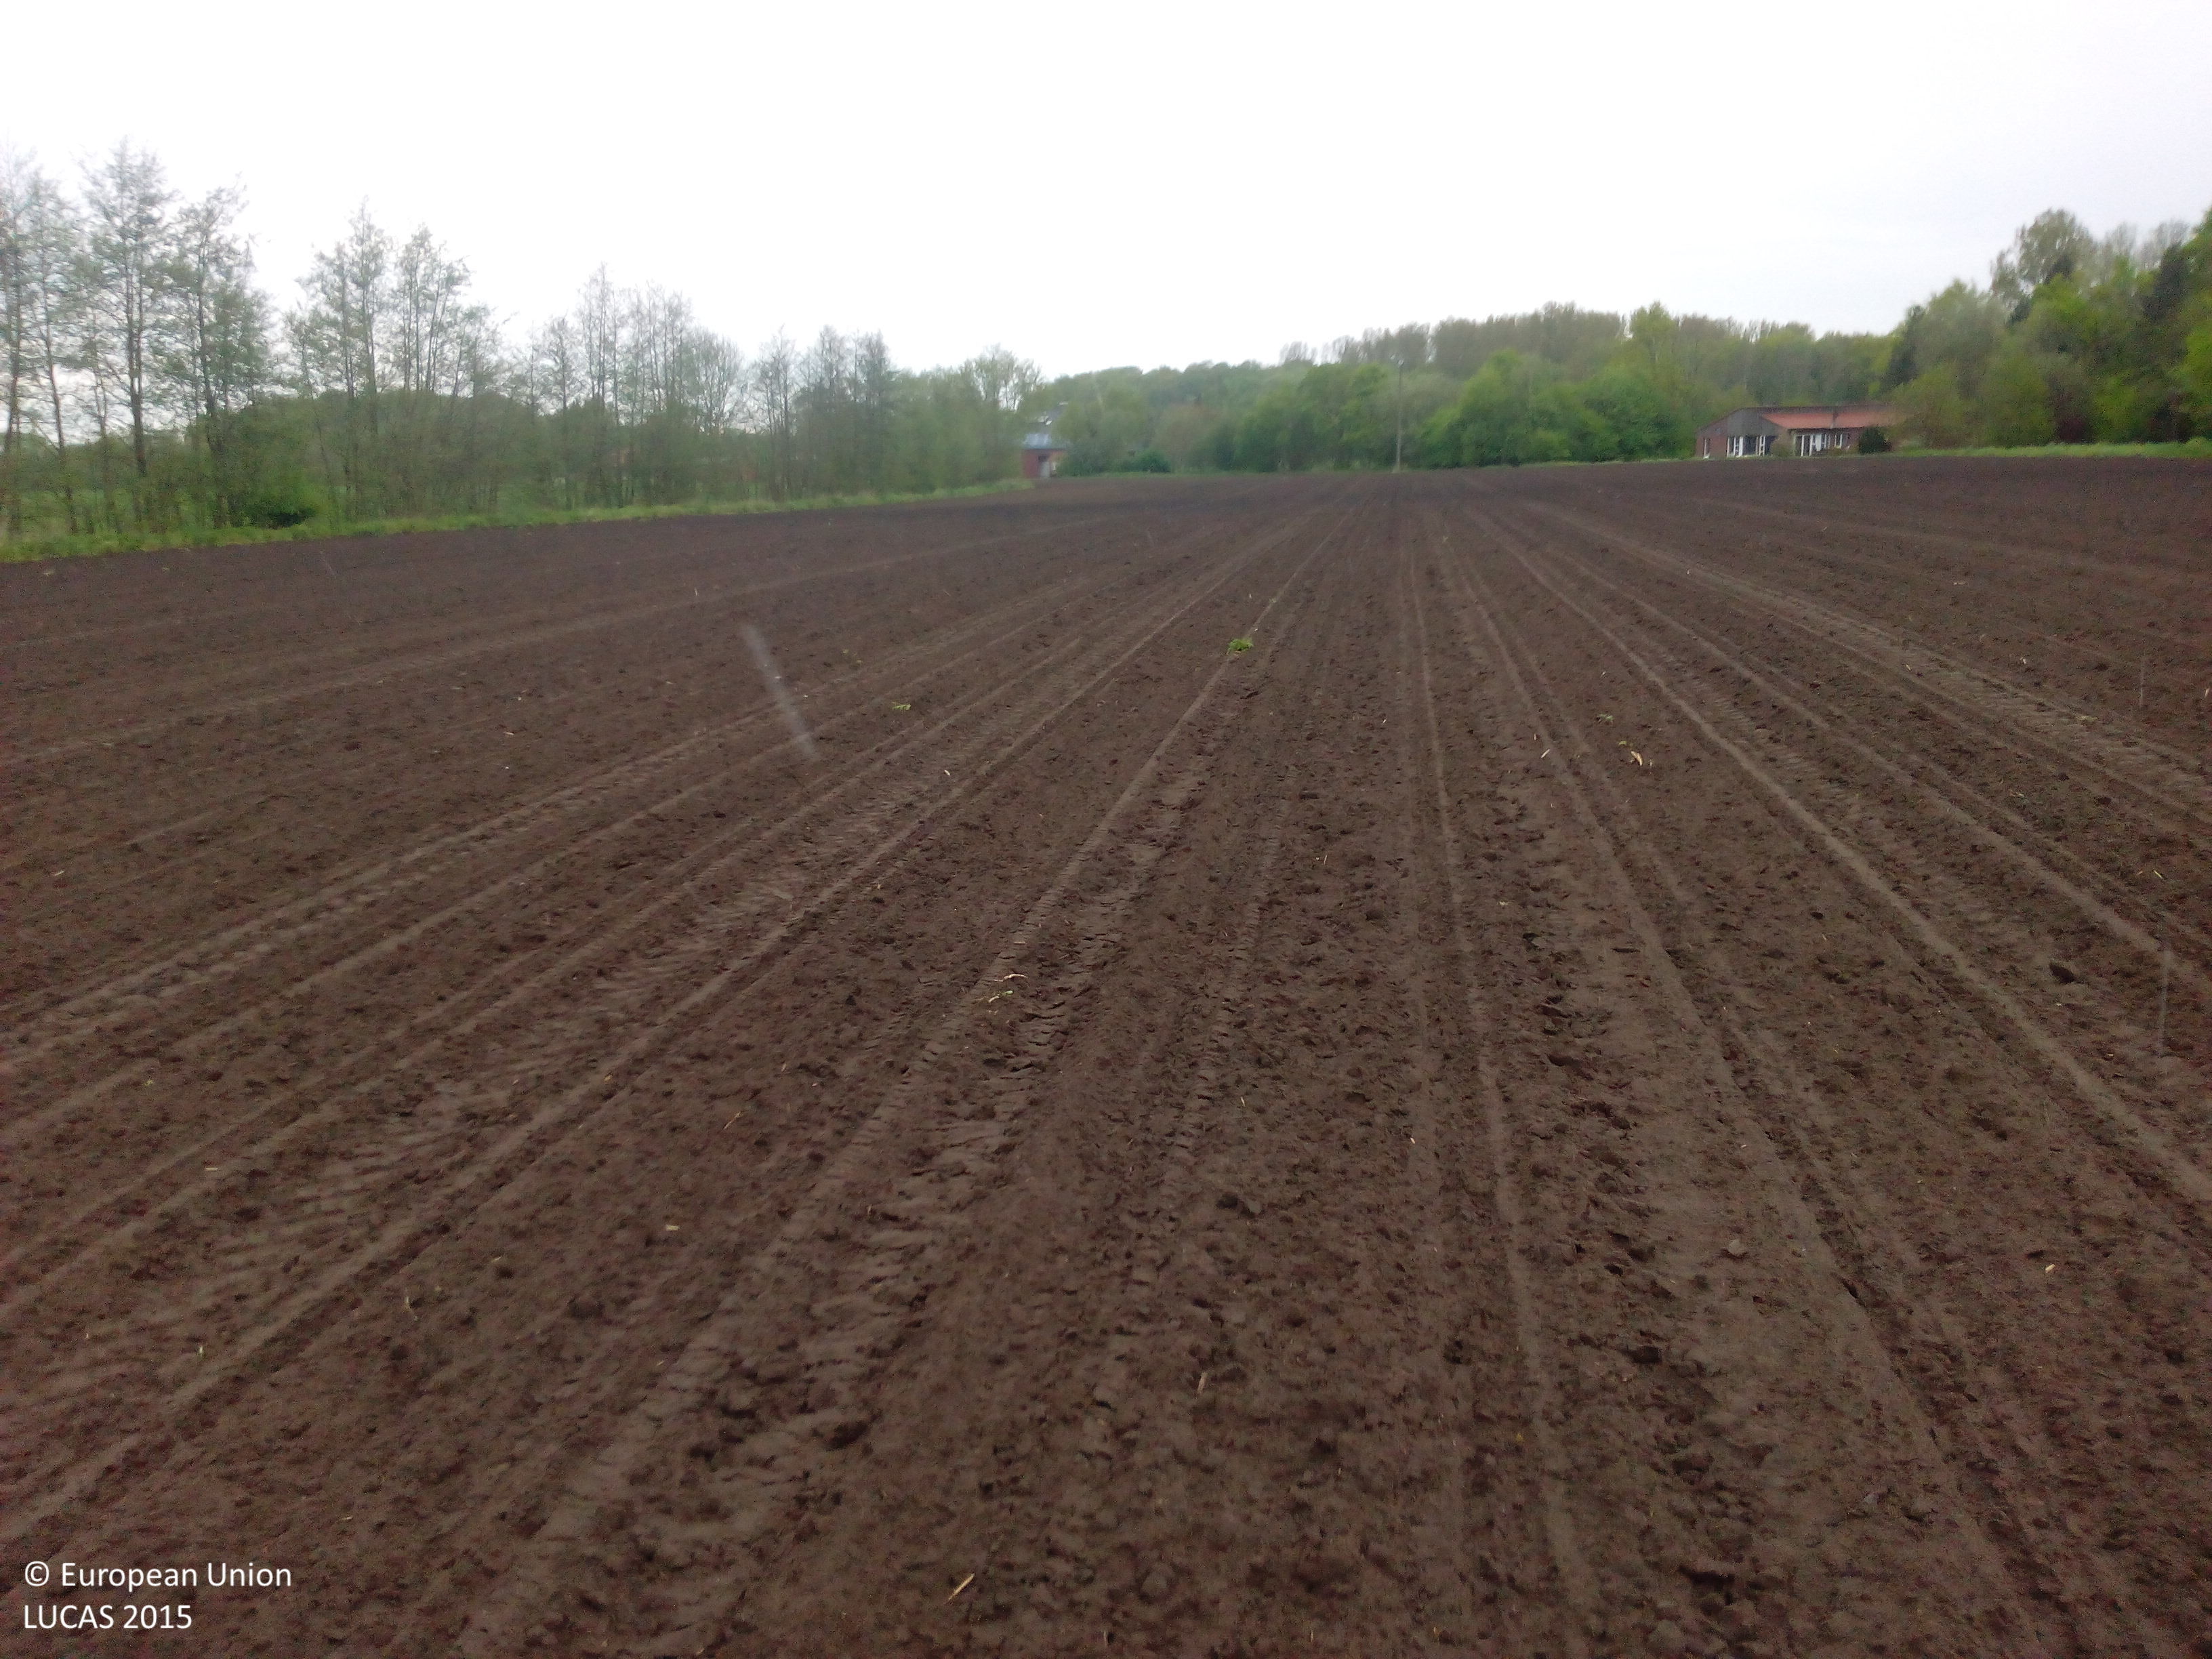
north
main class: Cropland
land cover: Maize
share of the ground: < 10 %
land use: Agriculture (excluding fallow land and kitchen gardens)
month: May
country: DE
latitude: 51.9905
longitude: 7.4518
